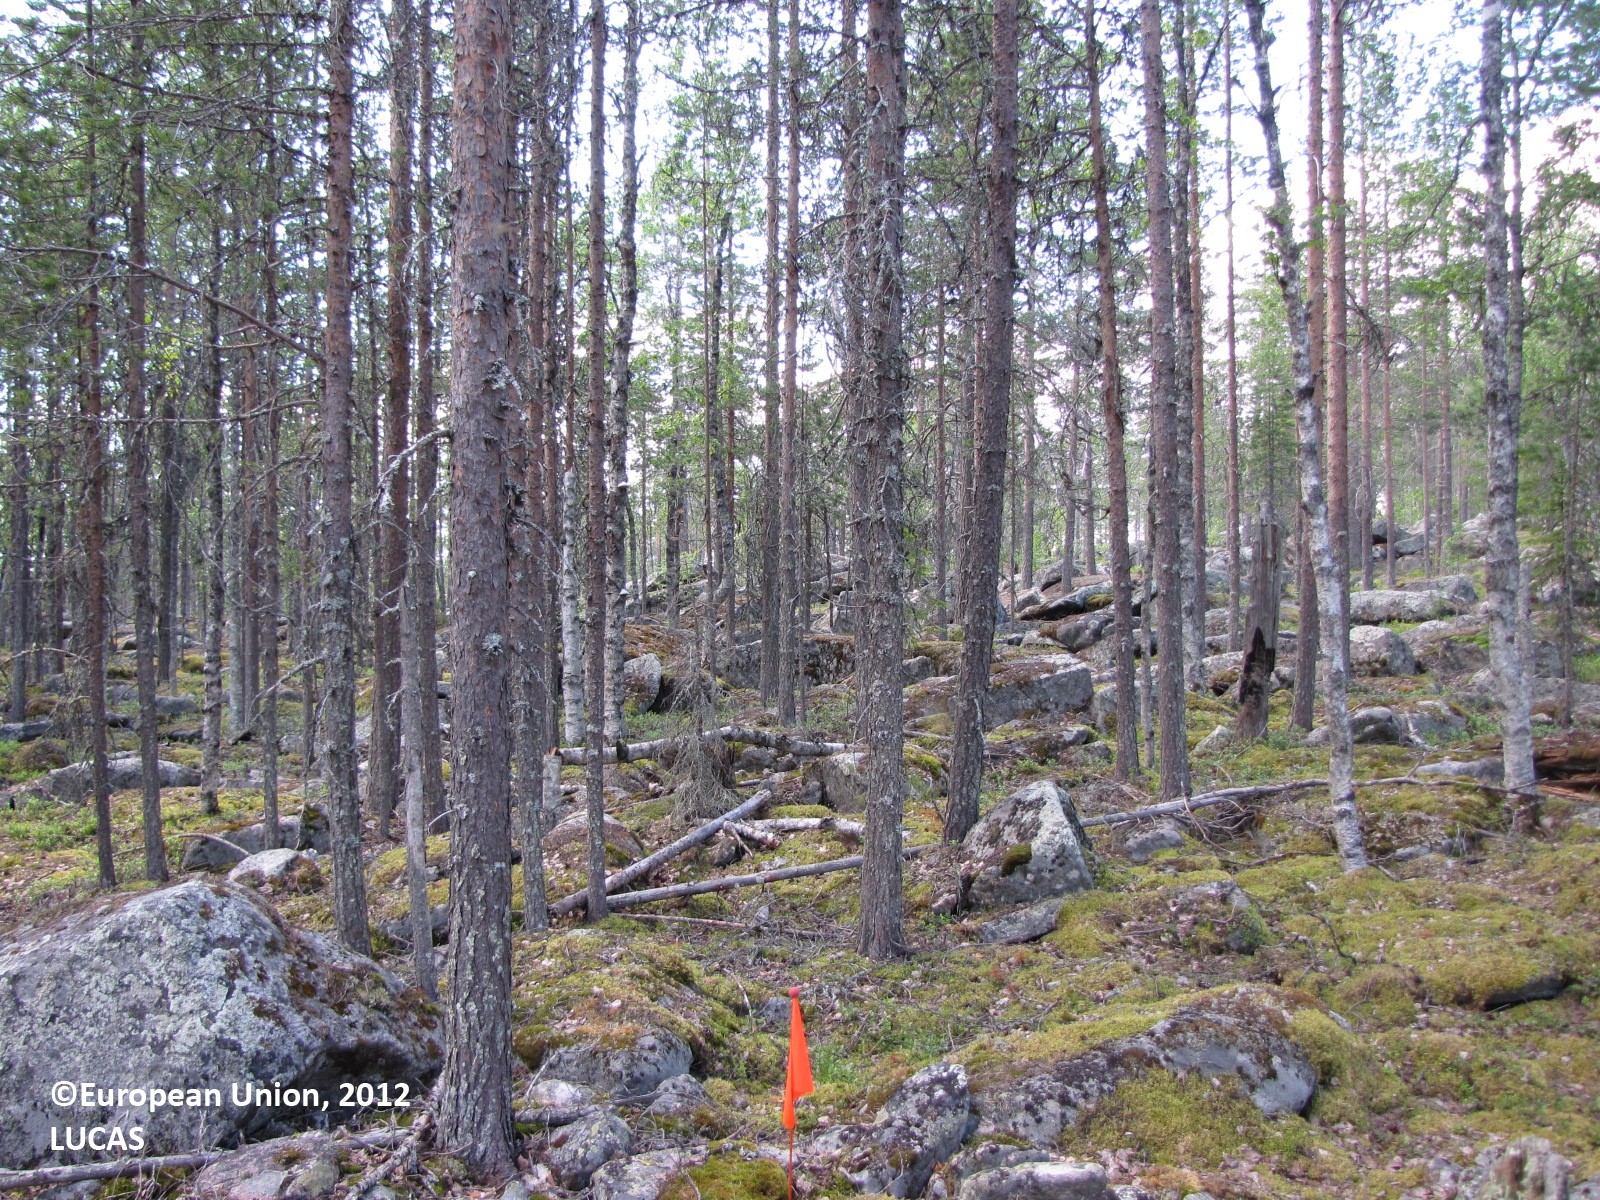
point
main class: Woodland
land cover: Pine dominated mixed woodland
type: boreal forest
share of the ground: 50 - 75 %
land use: Forestry
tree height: > 5 m
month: July
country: FI
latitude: 66.5139
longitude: 24.5033
